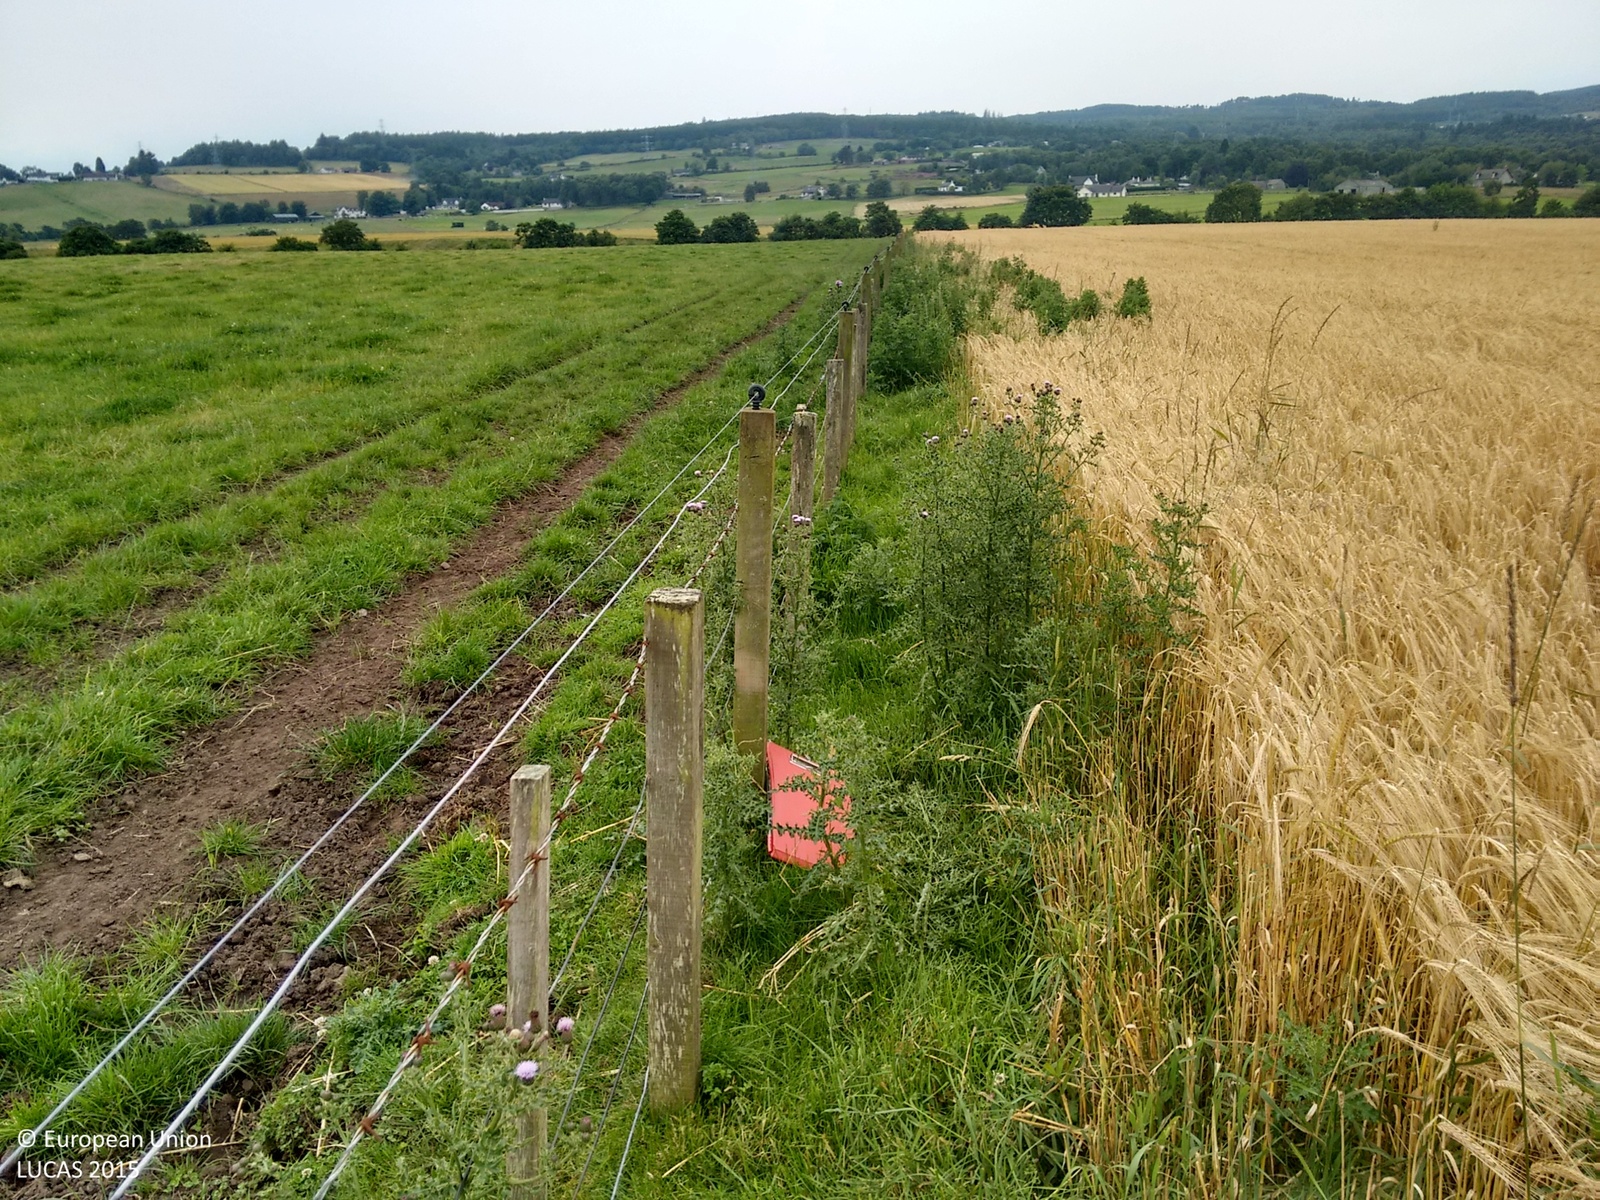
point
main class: Cropland
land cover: Barley
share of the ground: > 75 %
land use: Agriculture (excluding fallow land and kitchen gardens)
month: August
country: GB
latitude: 57.5048
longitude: -4.4597
